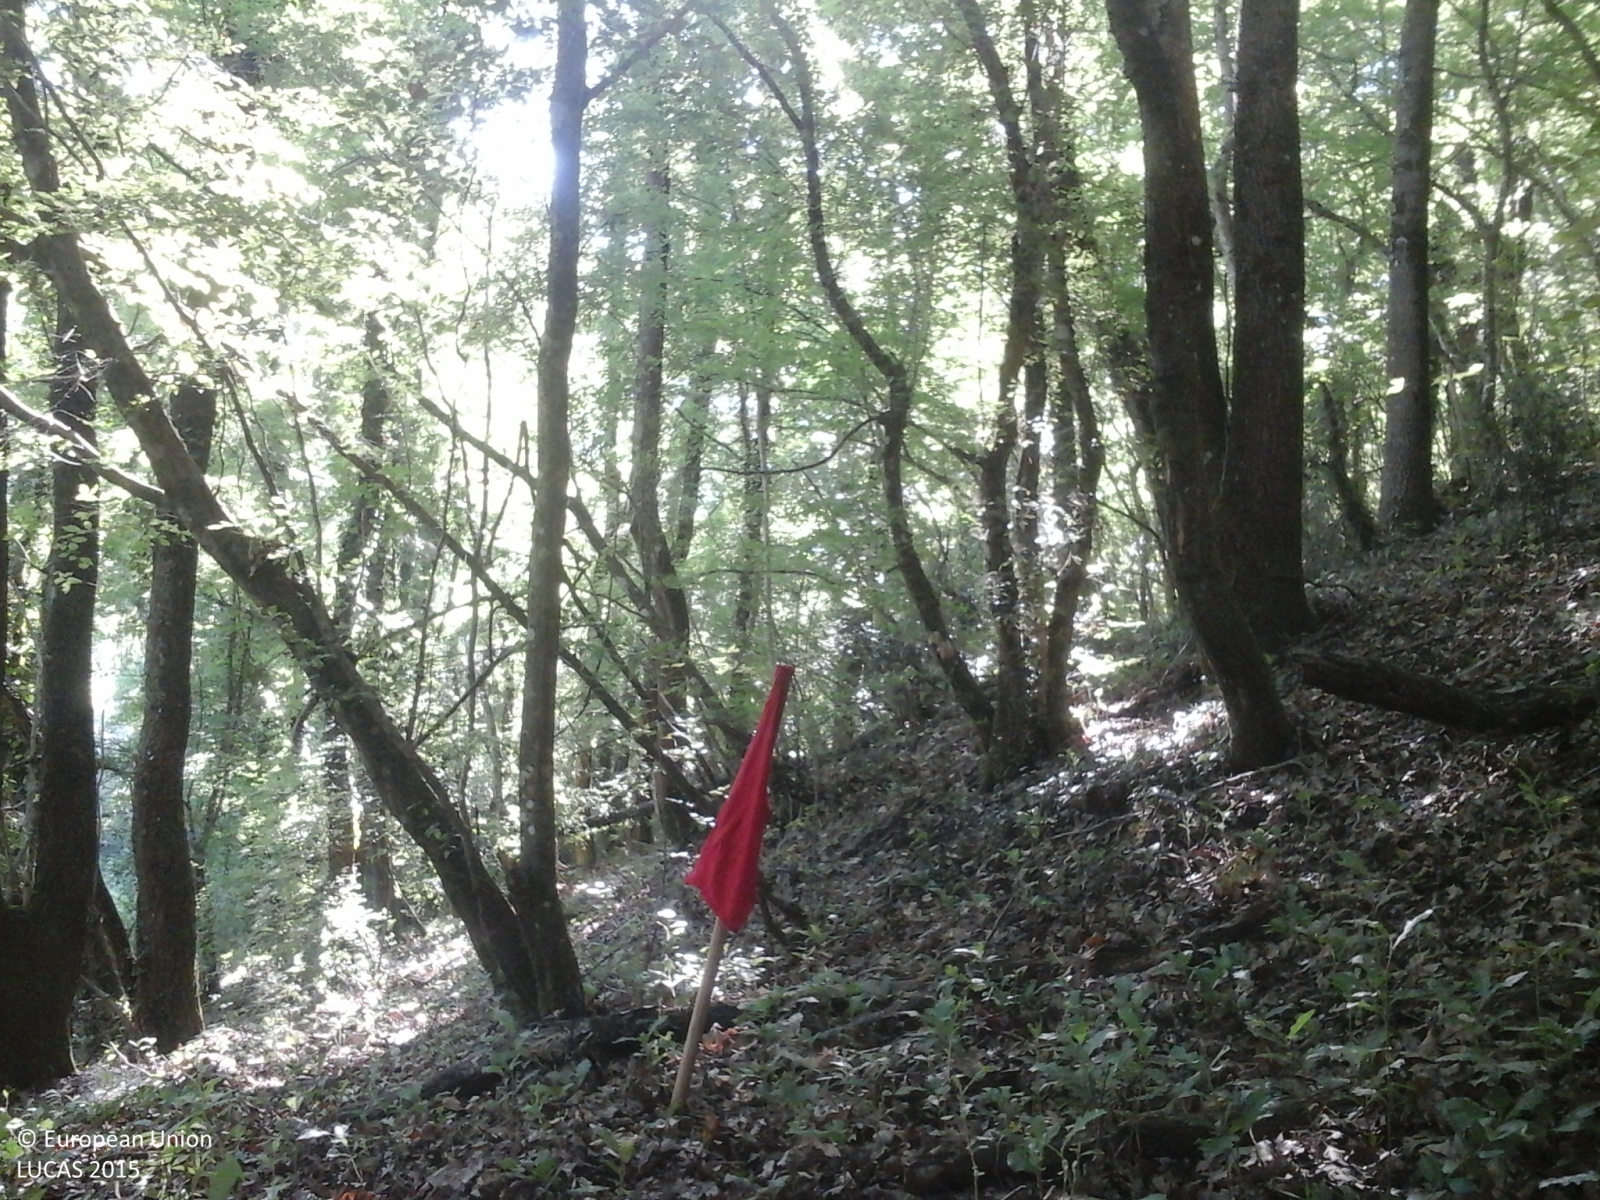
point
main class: Woodland
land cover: Broadleaved woodland
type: thermophilous deciduous forest
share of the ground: > 75 %
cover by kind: broadleaved forest trees 100 %
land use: Forestry
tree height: > 5 m
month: June
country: IT
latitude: 42.2160
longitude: 12.8612
